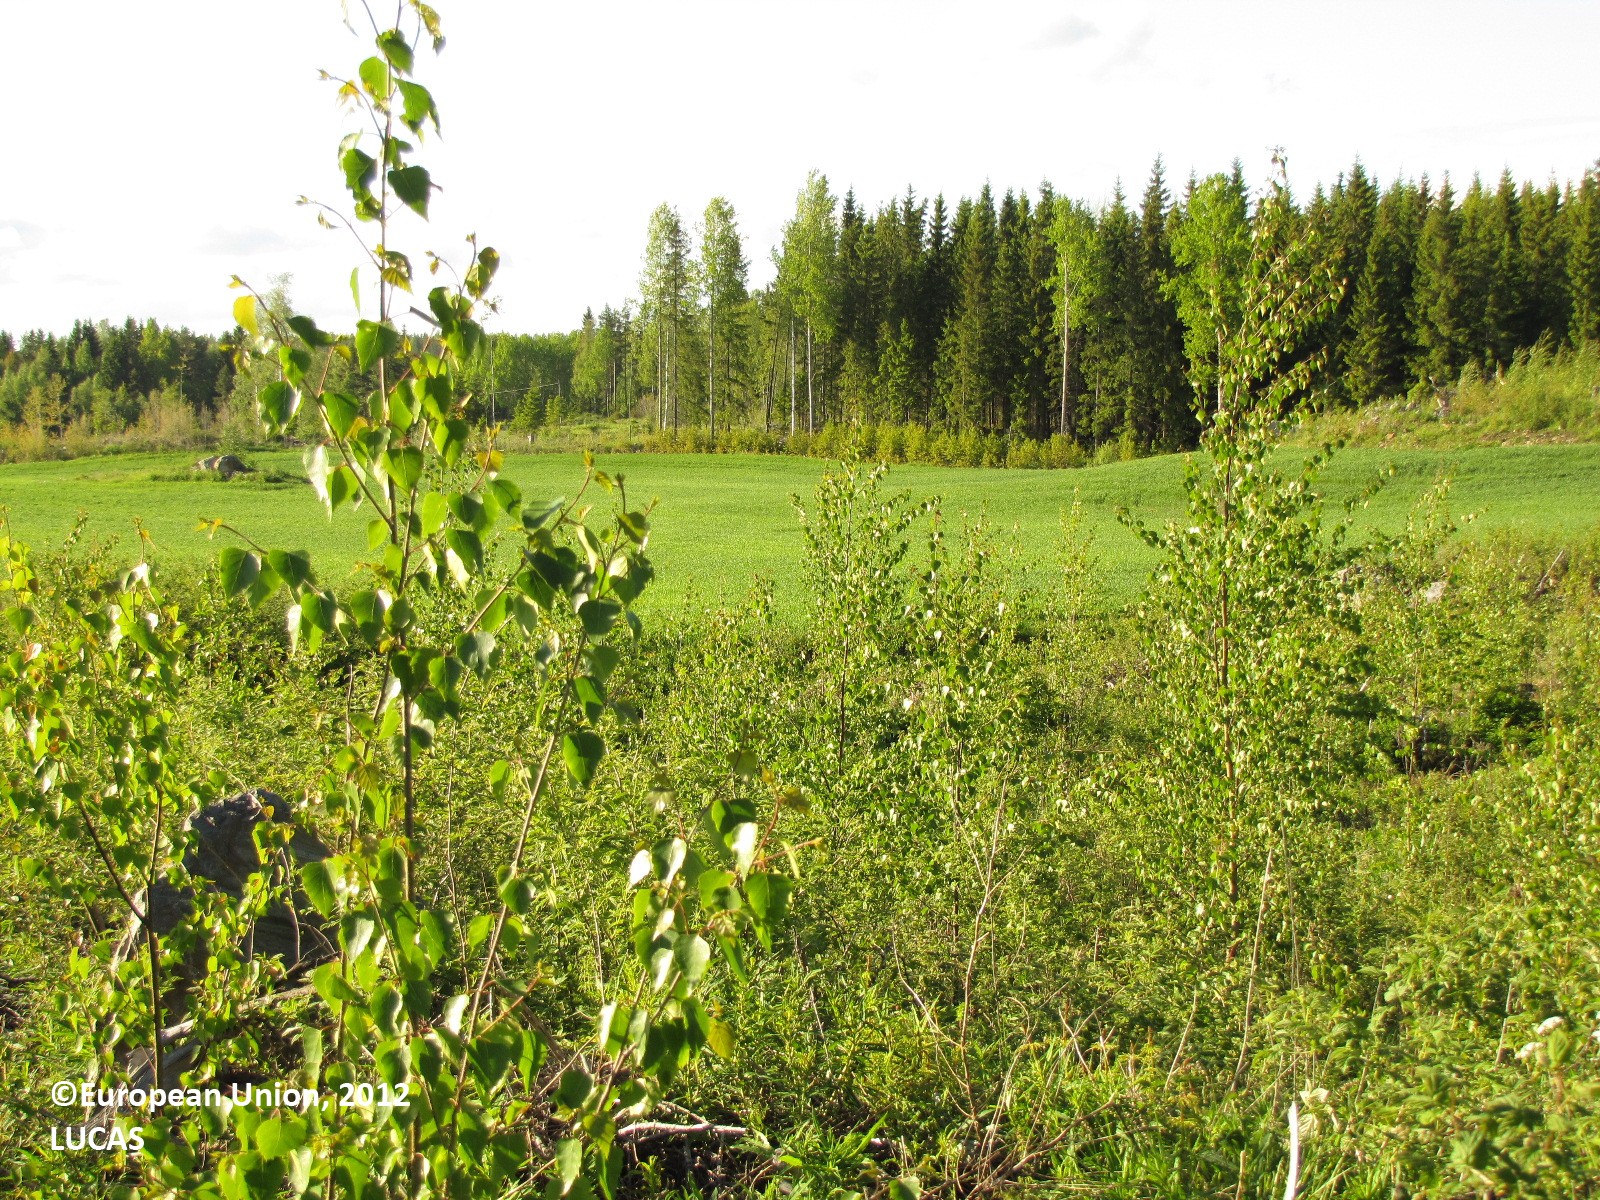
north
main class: Woodland
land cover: Broadleaved woodland
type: boreal forest
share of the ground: 25 - 50 %
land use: Forestry
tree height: < 5 m
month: June
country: FI
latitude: 61.3926
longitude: 22.9330
